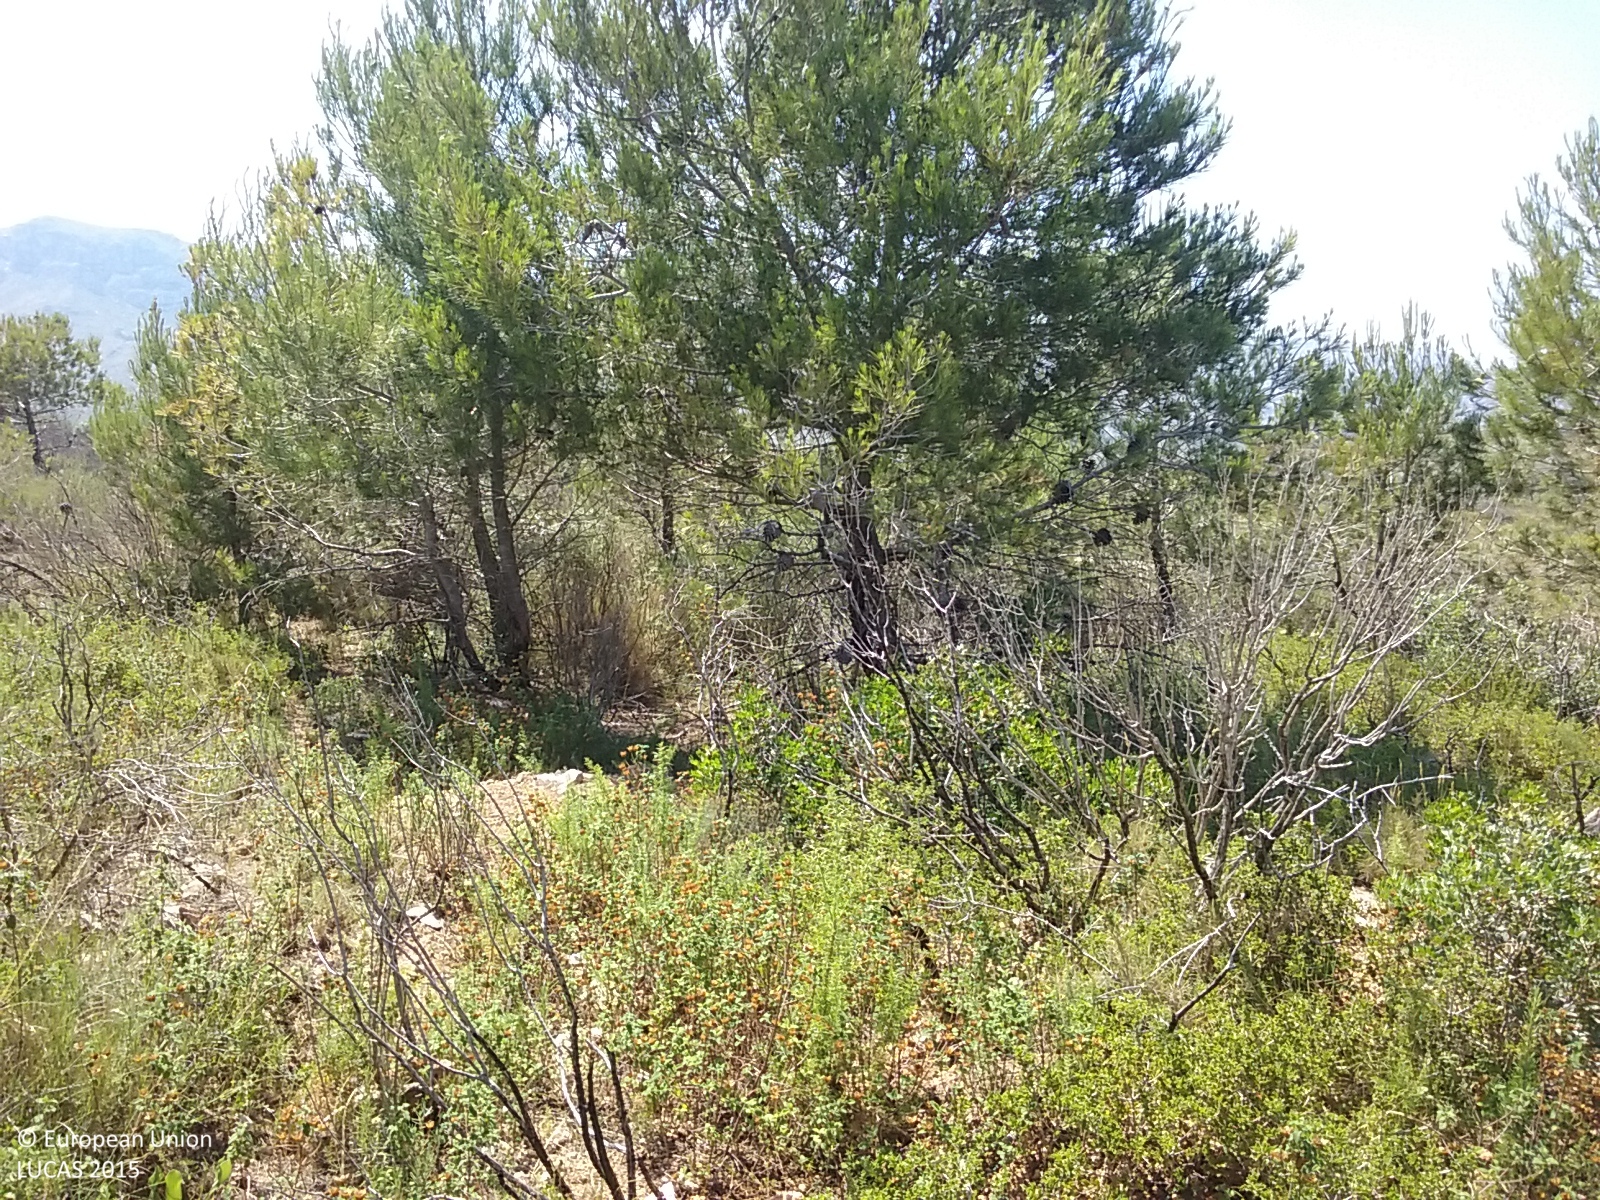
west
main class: Woodland
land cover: Pine dominated coniferous woodland
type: coniferous forest of the mediterranean region
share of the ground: 10 - 25 %
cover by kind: shrubs 75 %, coniferous forest trees 15 %, herbaceous plants 10 %
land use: Semi-natural and natural areas not in use
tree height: < 5 m
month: June
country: ES
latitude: 40.9297
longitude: 0.6470
